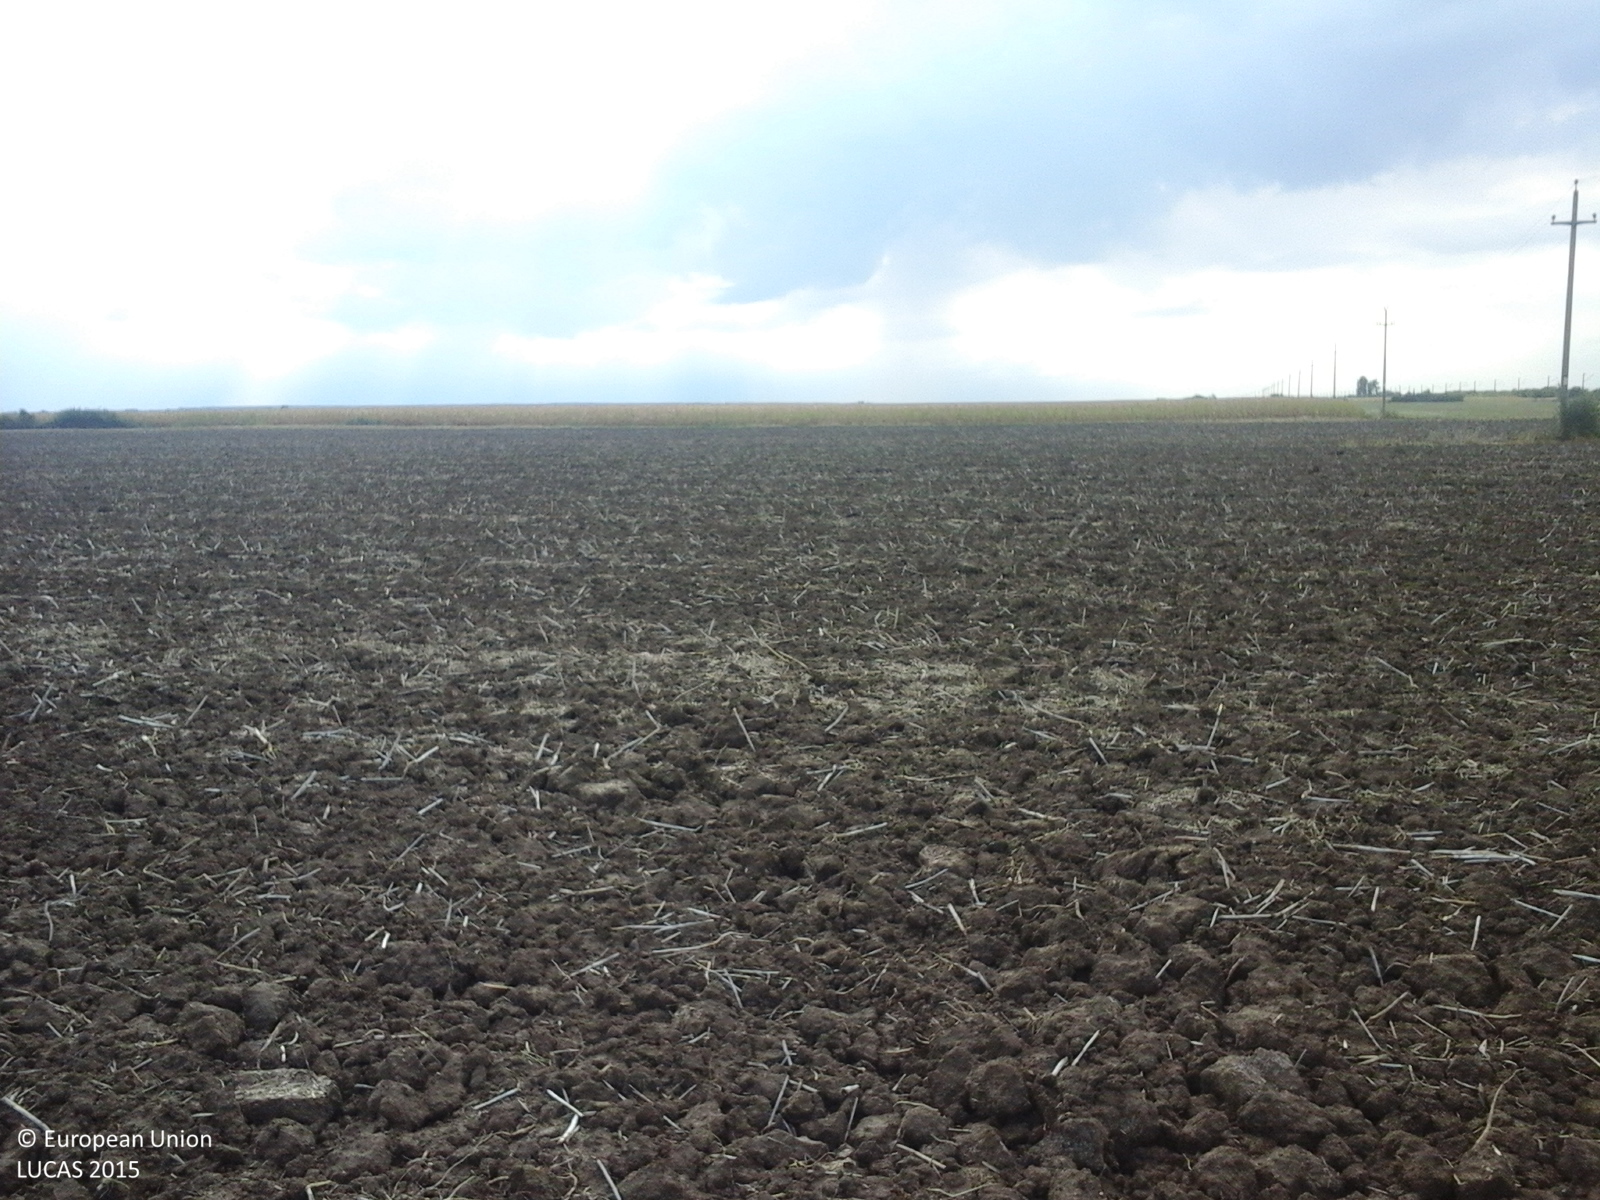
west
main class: Cropland
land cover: Rape and turnip rape
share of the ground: < 10 %
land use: Agriculture (excluding fallow land and kitchen gardens)
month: August
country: RO
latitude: 45.7728
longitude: 21.5961
